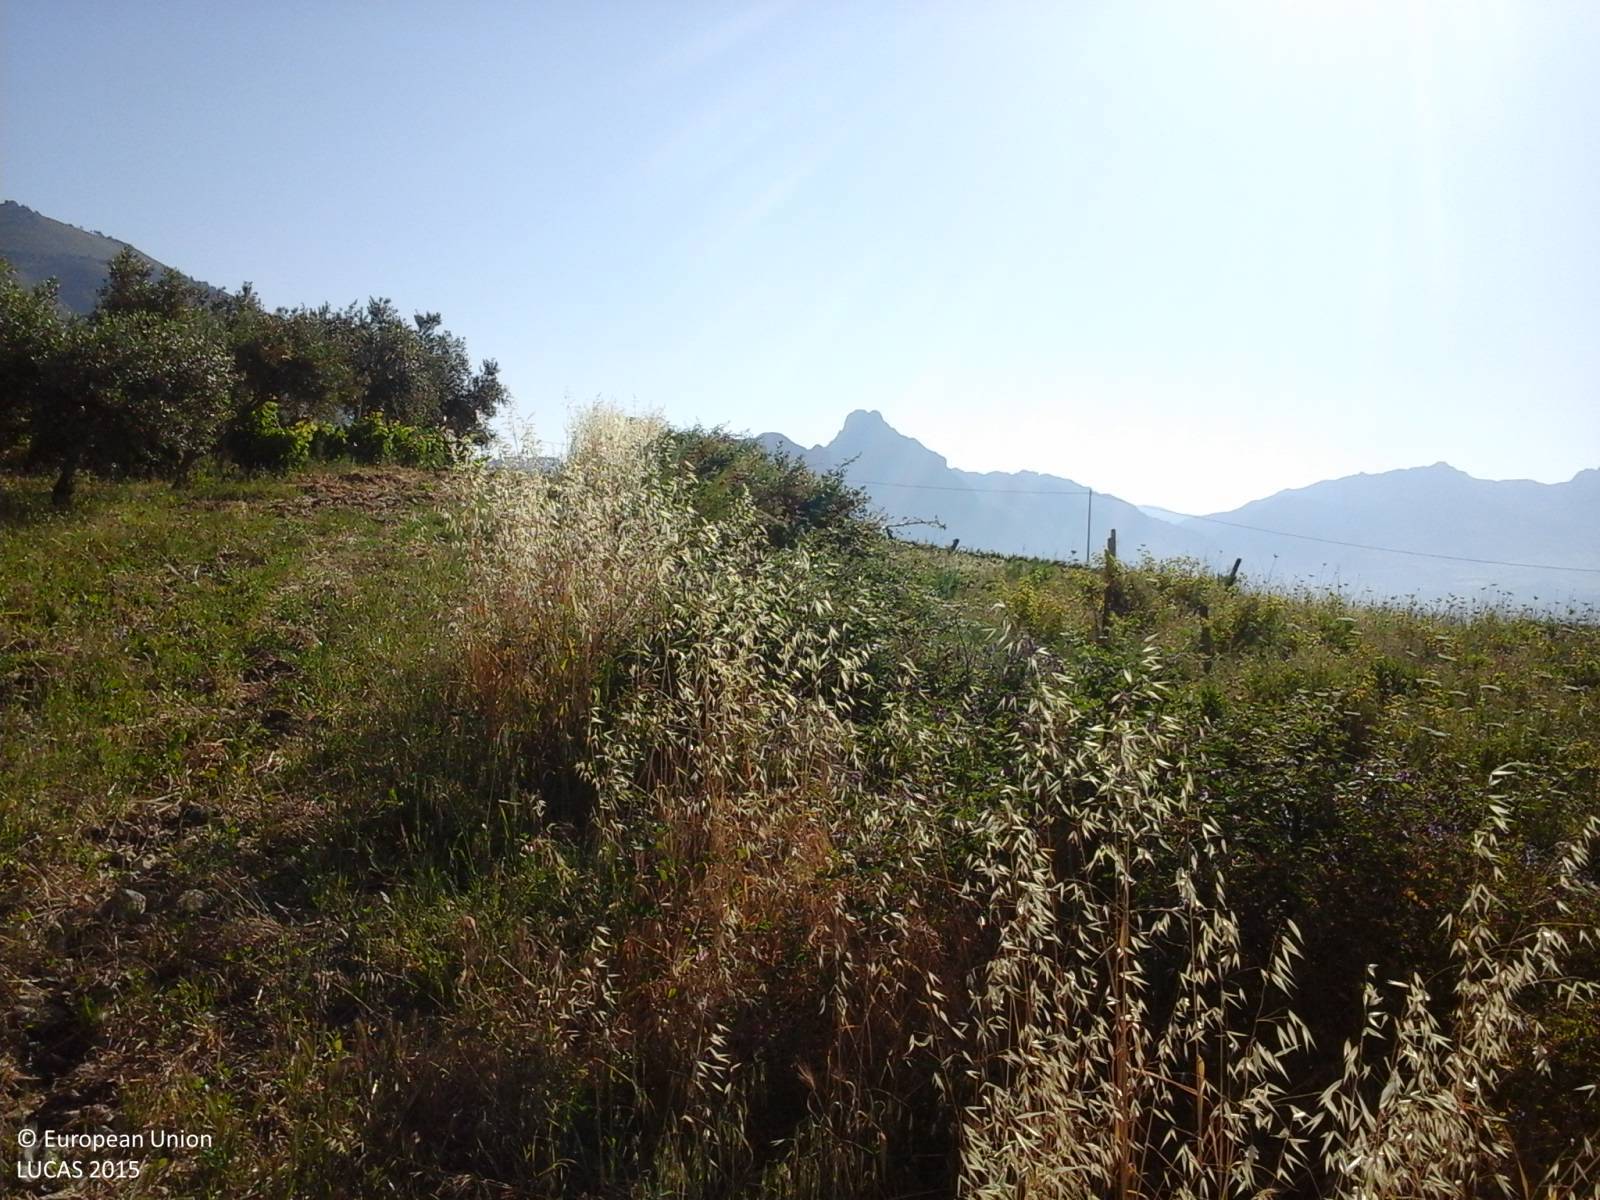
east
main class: Grassland
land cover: Grassland with sparse tree/shrub cover
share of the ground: > 75 %
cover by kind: herbaceous plants 95 %, broadleaved forest trees 5 %
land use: Abandoned areas
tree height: > 5 m
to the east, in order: Grassland with sparse tree/shrub cover; Fences; Olive groves; Grass margins; Fences; Tracks; Fences; Vineyards
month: June
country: IT
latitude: 37.9859
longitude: 13.1540
